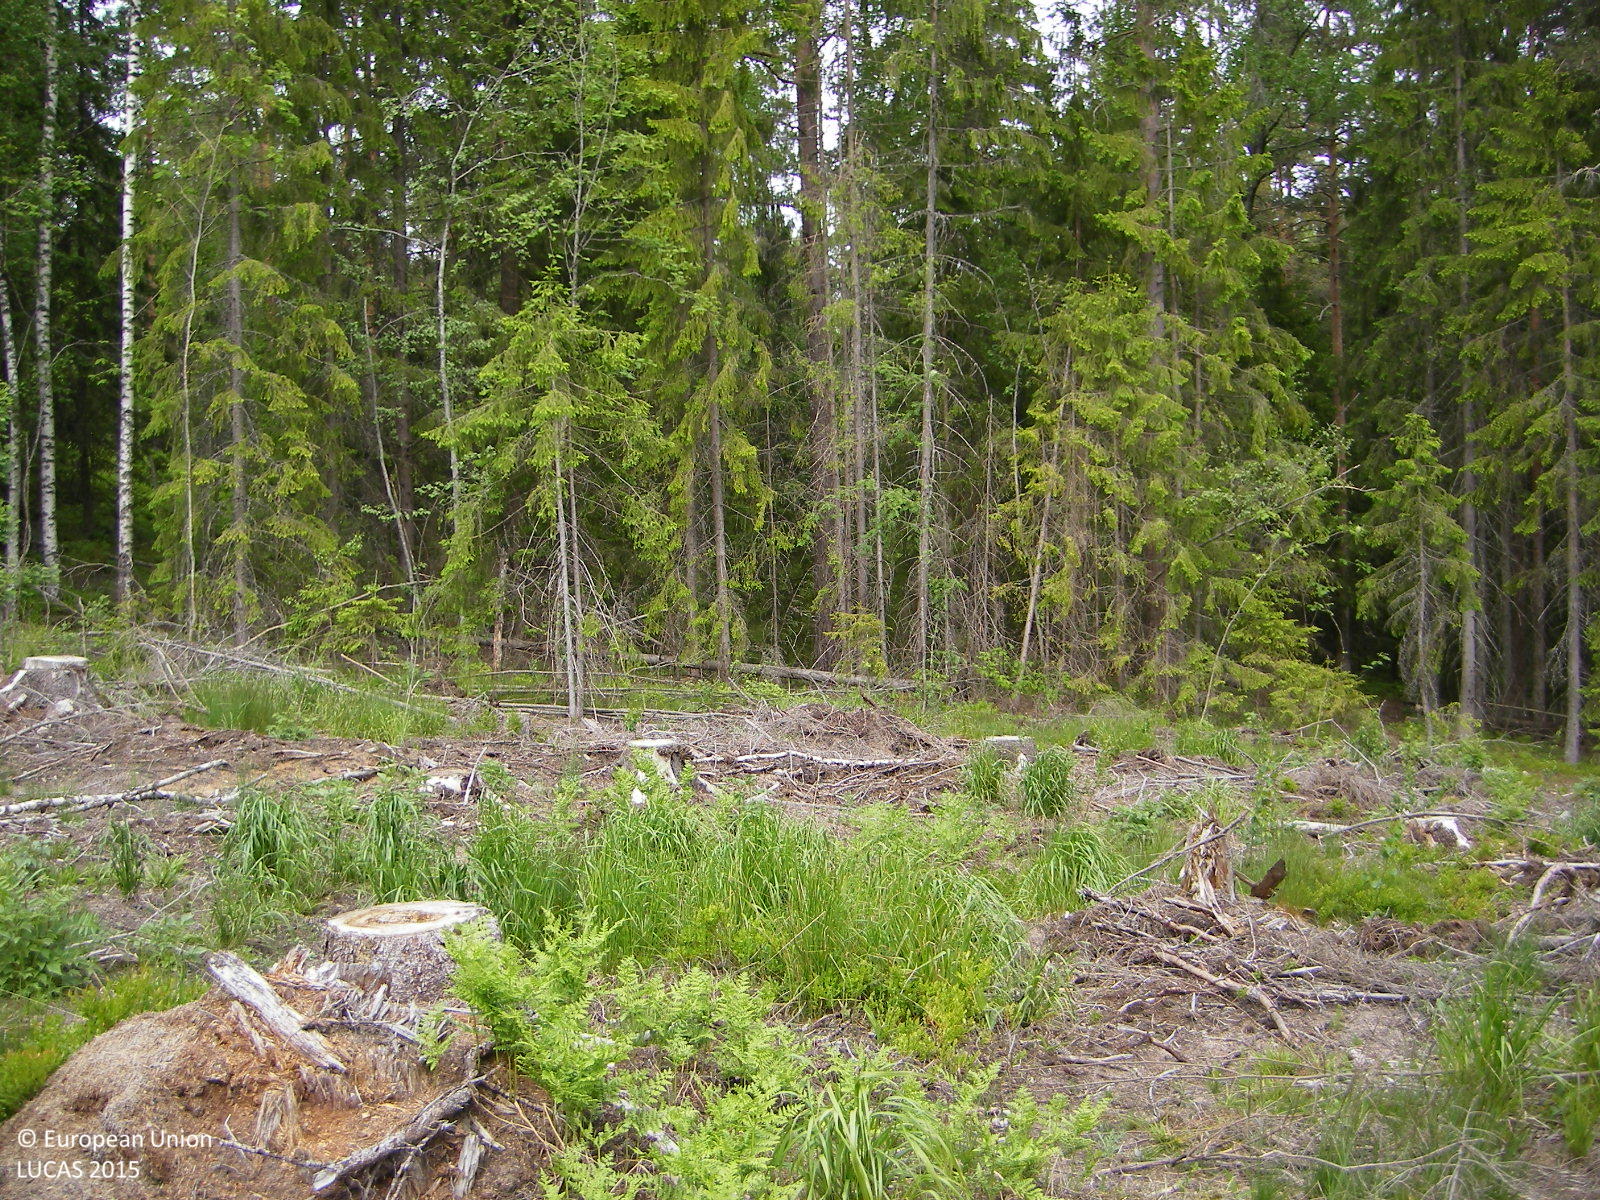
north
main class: Grassland
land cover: Grassland with sparse tree/shrub cover
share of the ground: 25 - 50 %
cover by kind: unconsolidated bare surface 50 %, herbaceous plants 40 %, broadleaved forest trees 5 %, shrubs 5 %
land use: Forestry
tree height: < 5 m
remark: Clear cut
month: June
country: FI
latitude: 60.3180
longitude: 24.3895
